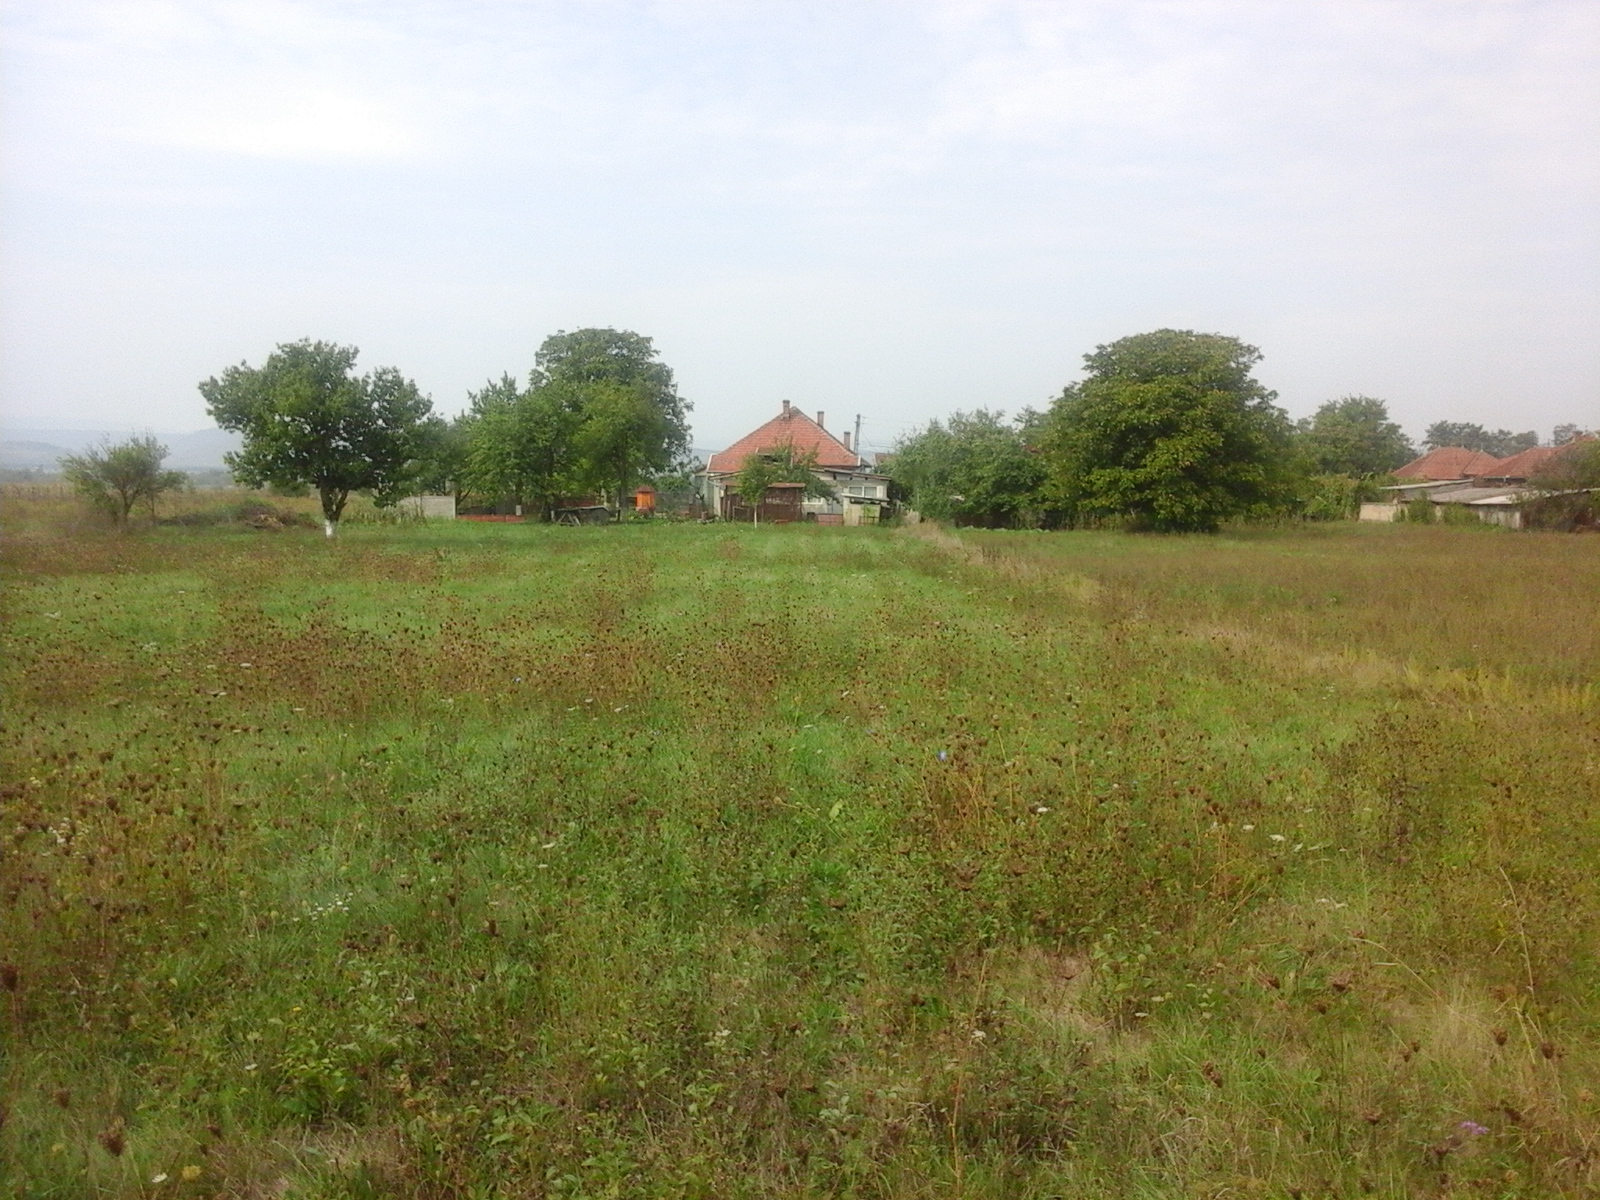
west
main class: Grassland
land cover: Spontaneously vegetated surfaces
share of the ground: > 75 %
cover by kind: herbaceous plants 100 %
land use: Agriculture (excluding fallow land and kitchen gardens)
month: September
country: RO
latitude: 45.7159
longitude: 23.0170
